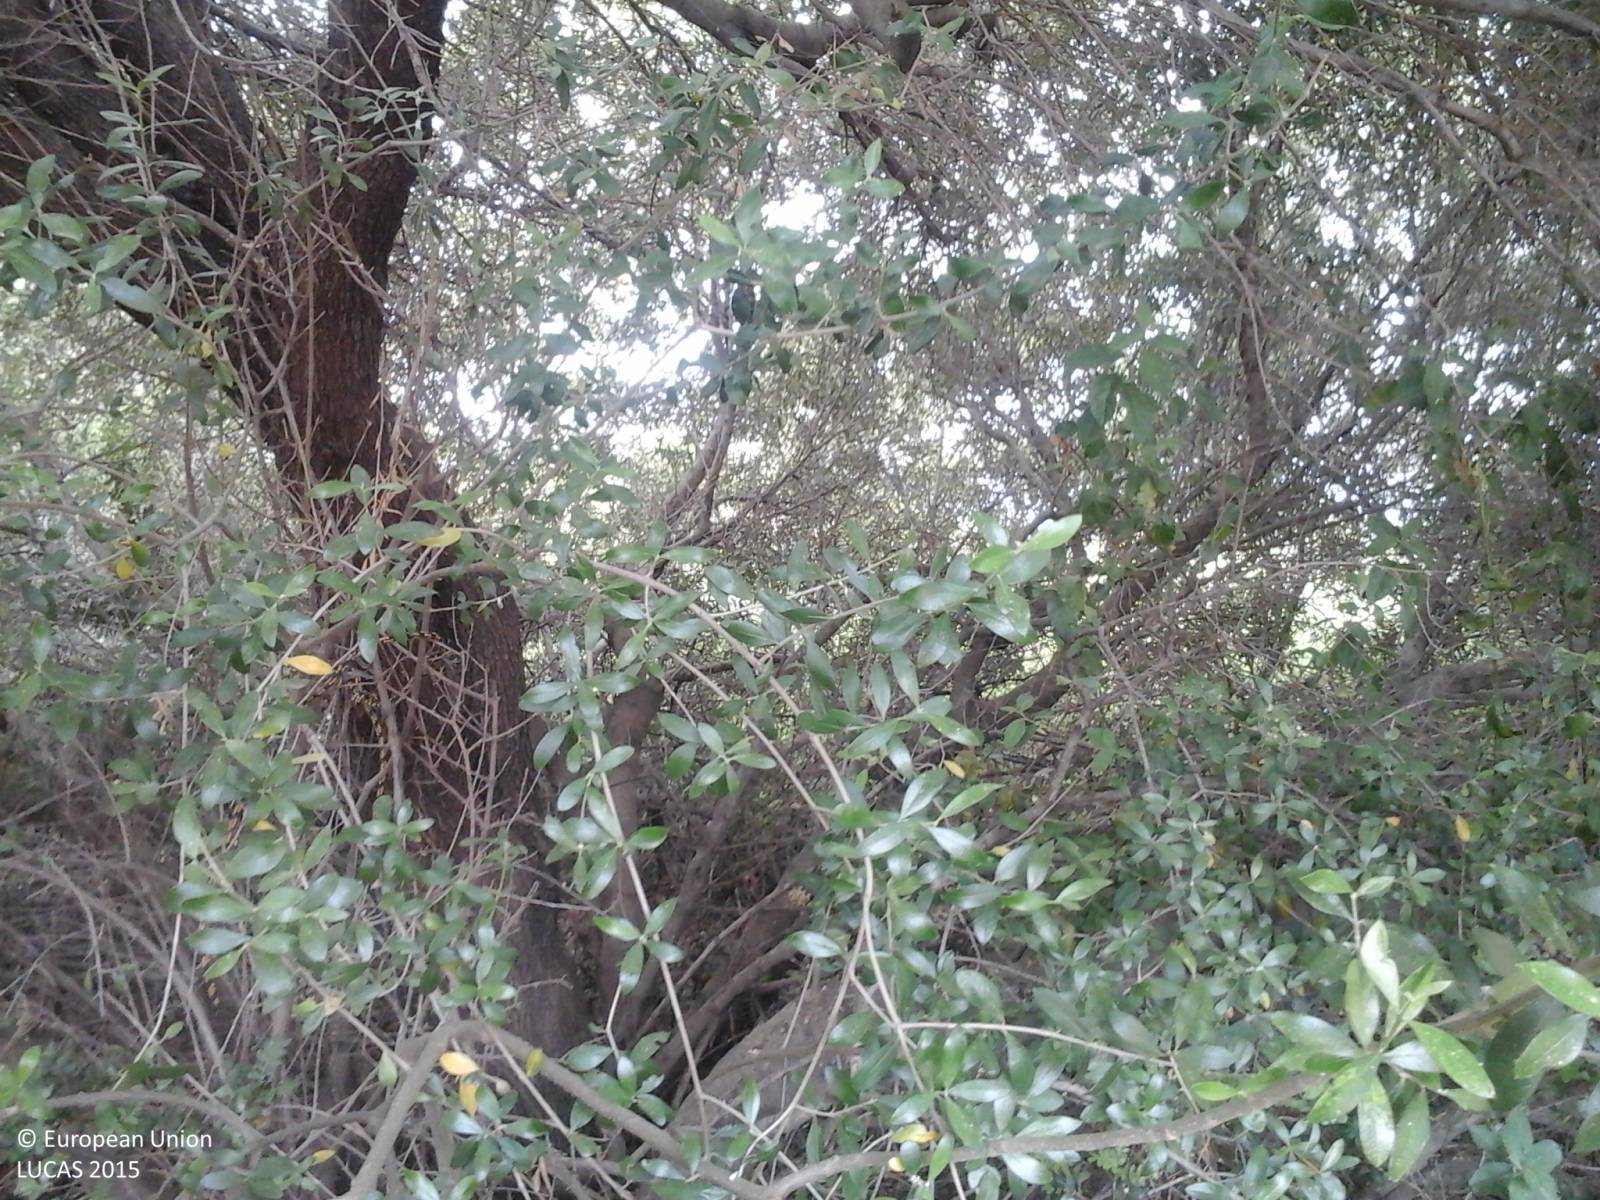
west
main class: Woodland
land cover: Broadleaved woodland
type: broadleaved evergreen forest
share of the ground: > 75 %
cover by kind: broadleaved forest trees 45 %, shrubs 45 %
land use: Amenities, museums, leisure
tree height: > 5 m
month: May
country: IT
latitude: 40.9667
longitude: 8.8764
